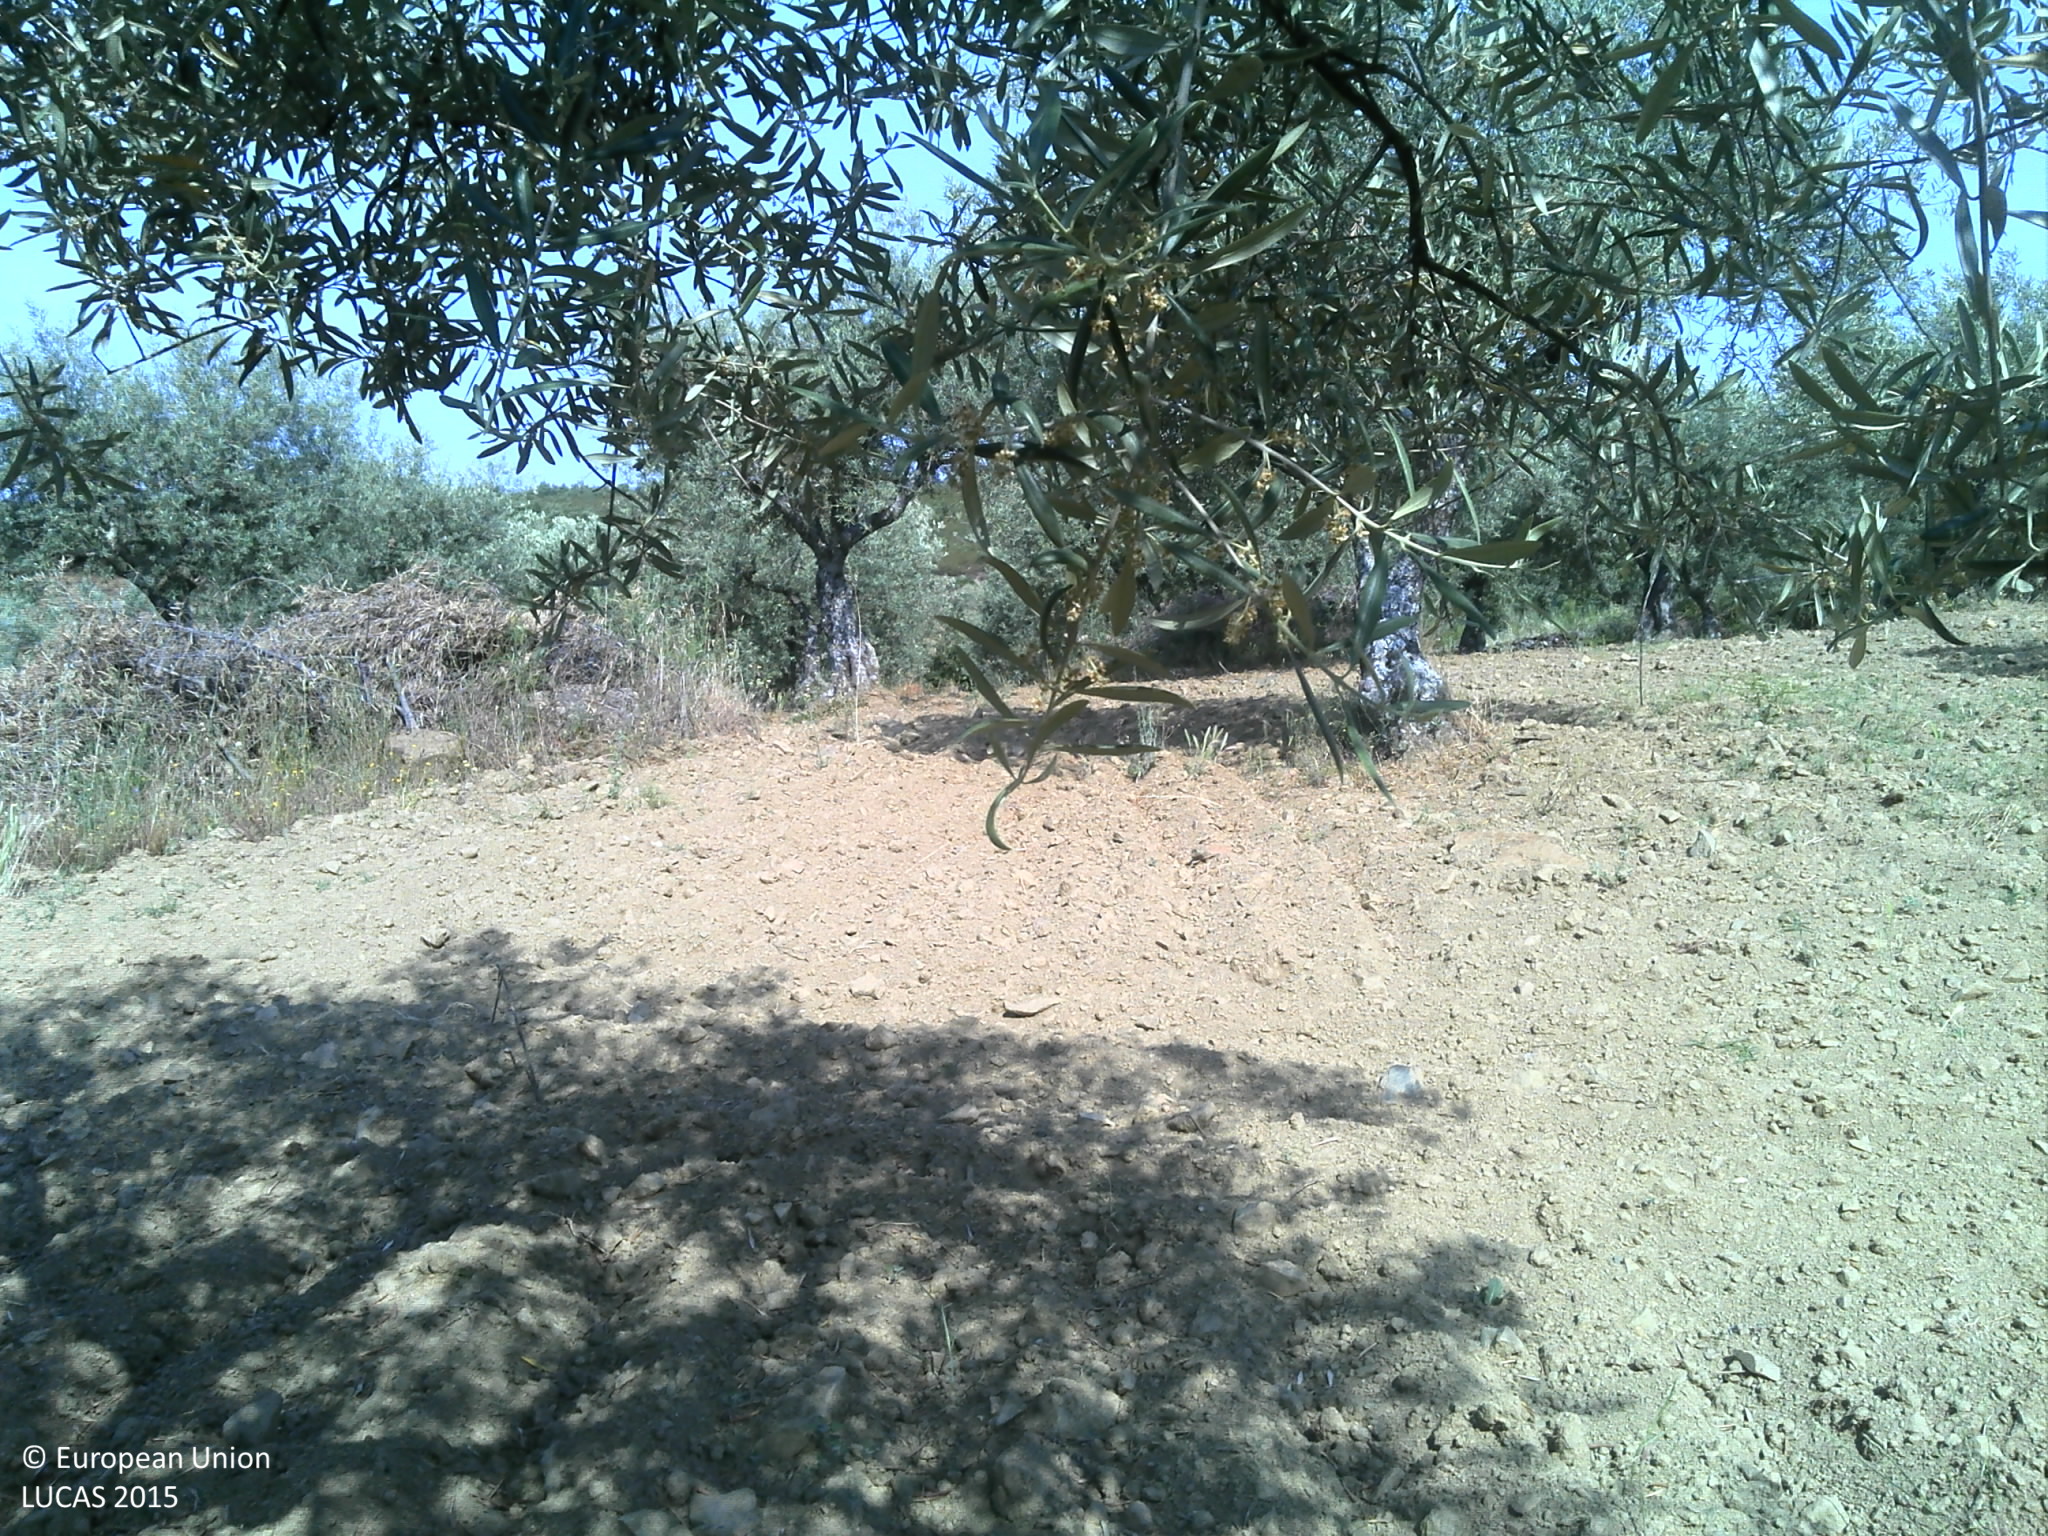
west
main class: Cropland
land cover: Olive groves
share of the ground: 10 - 25 %
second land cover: Spontaneously vegetated surfaces
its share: 10 - 25 %
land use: Agriculture (excluding fallow land and kitchen gardens)
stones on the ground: 10 - 25 %
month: June
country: PT
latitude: 41.5179
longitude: -6.9985
